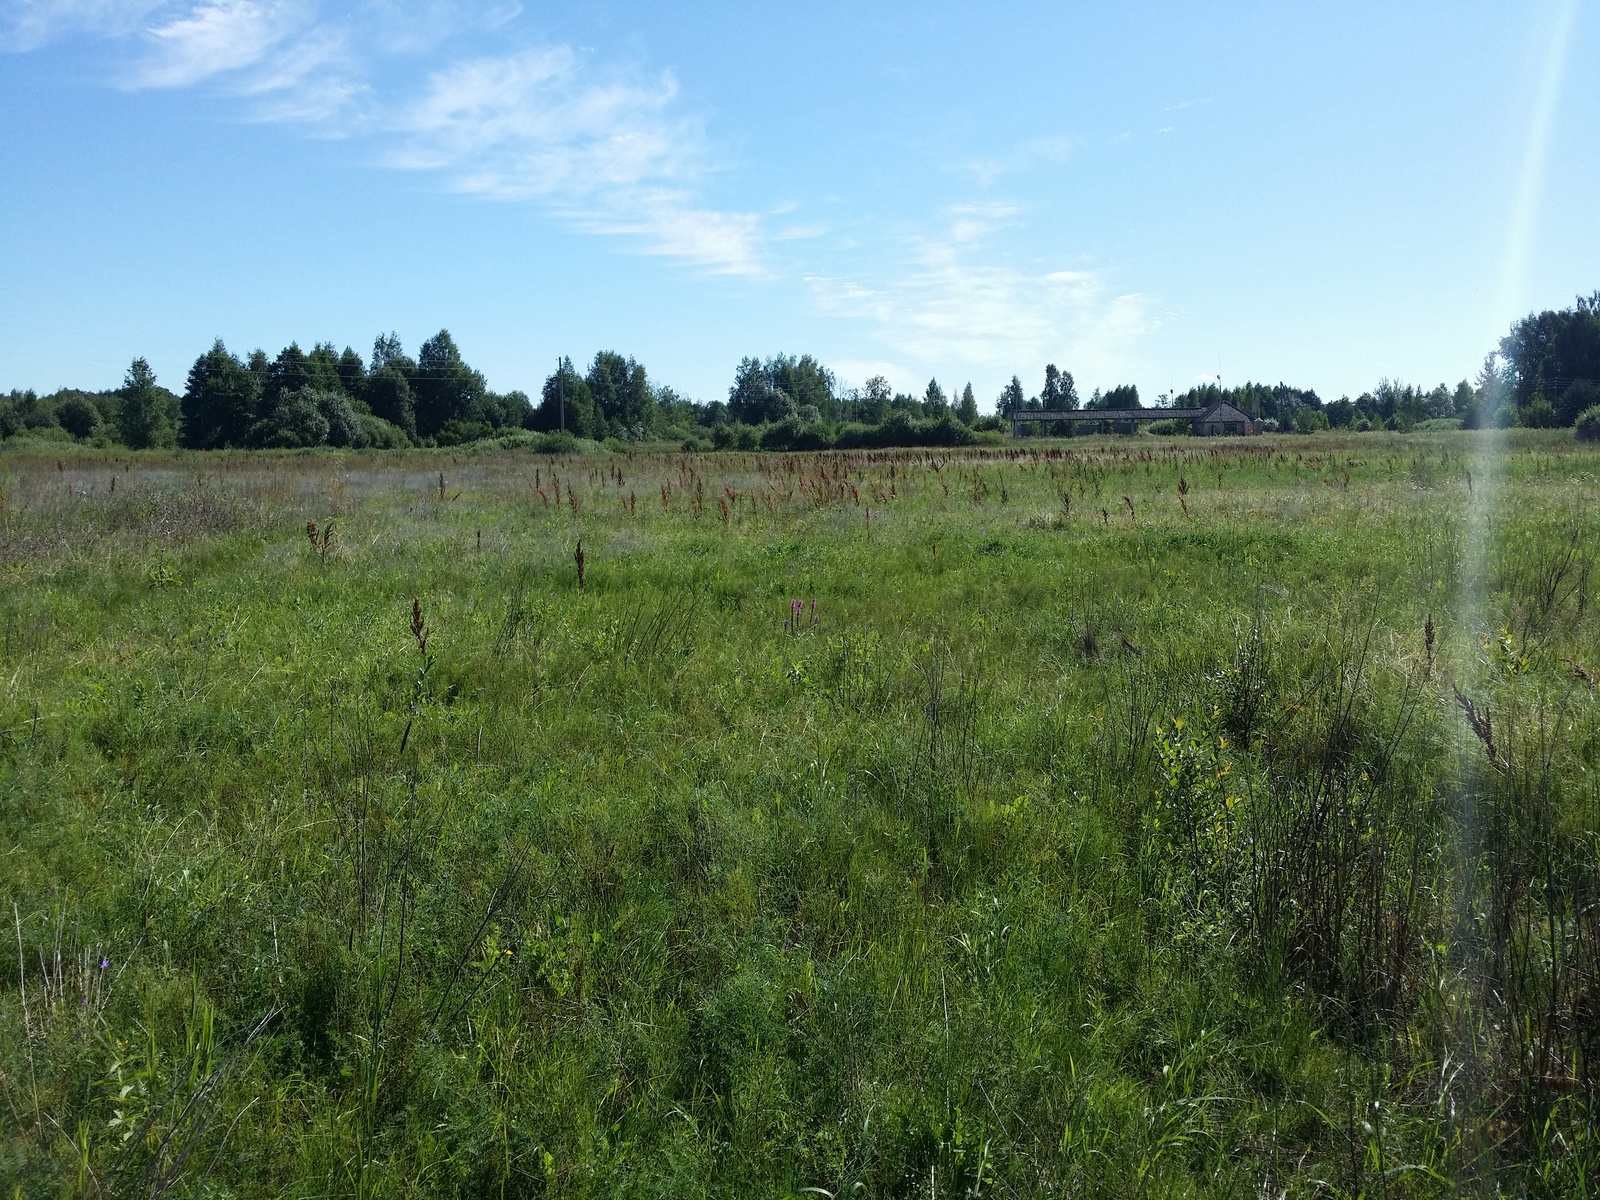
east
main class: Grassland
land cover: Grassland without tree/shrub cover
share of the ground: > 75 %
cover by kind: herbaceous plants 100 %
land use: Agriculture (excluding fallow land and kitchen gardens)
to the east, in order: Grassland without tree/shrub cover; Electric lines; Grassland without tree/shrub cover; Abandoned hedges; Paved roads, cycling and walking lanes; Spontaneously vegetated surfaces; Paved roads, cycling and walking lanes; Grass margins
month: August
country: LV
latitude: 57.0344
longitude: 27.5287
